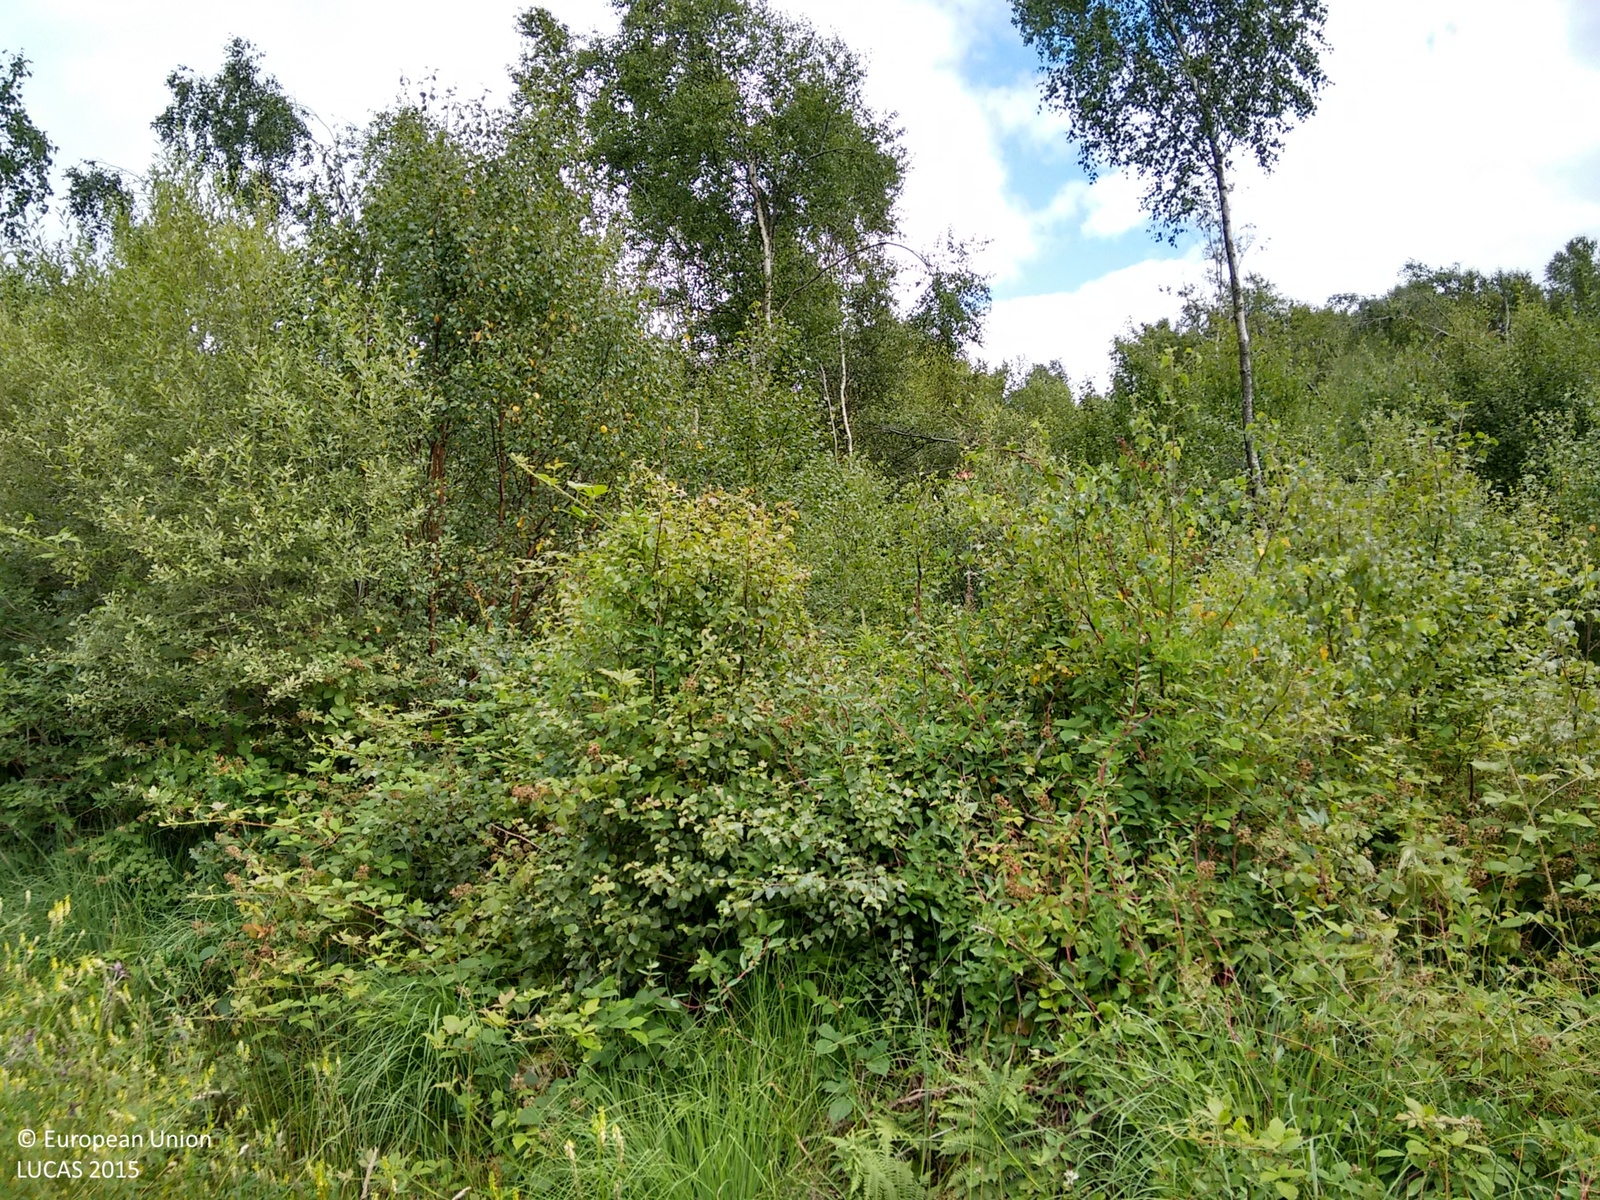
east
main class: Woodland
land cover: Broadleaved woodland
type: mesophytic deciduous forest
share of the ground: > 75 %
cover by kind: broadleaved forest trees 80 %, shrubs 20 %
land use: Forestry
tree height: > 5 m
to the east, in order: Broadleaved woodland
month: July
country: GB
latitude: 51.6889
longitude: -3.9959
